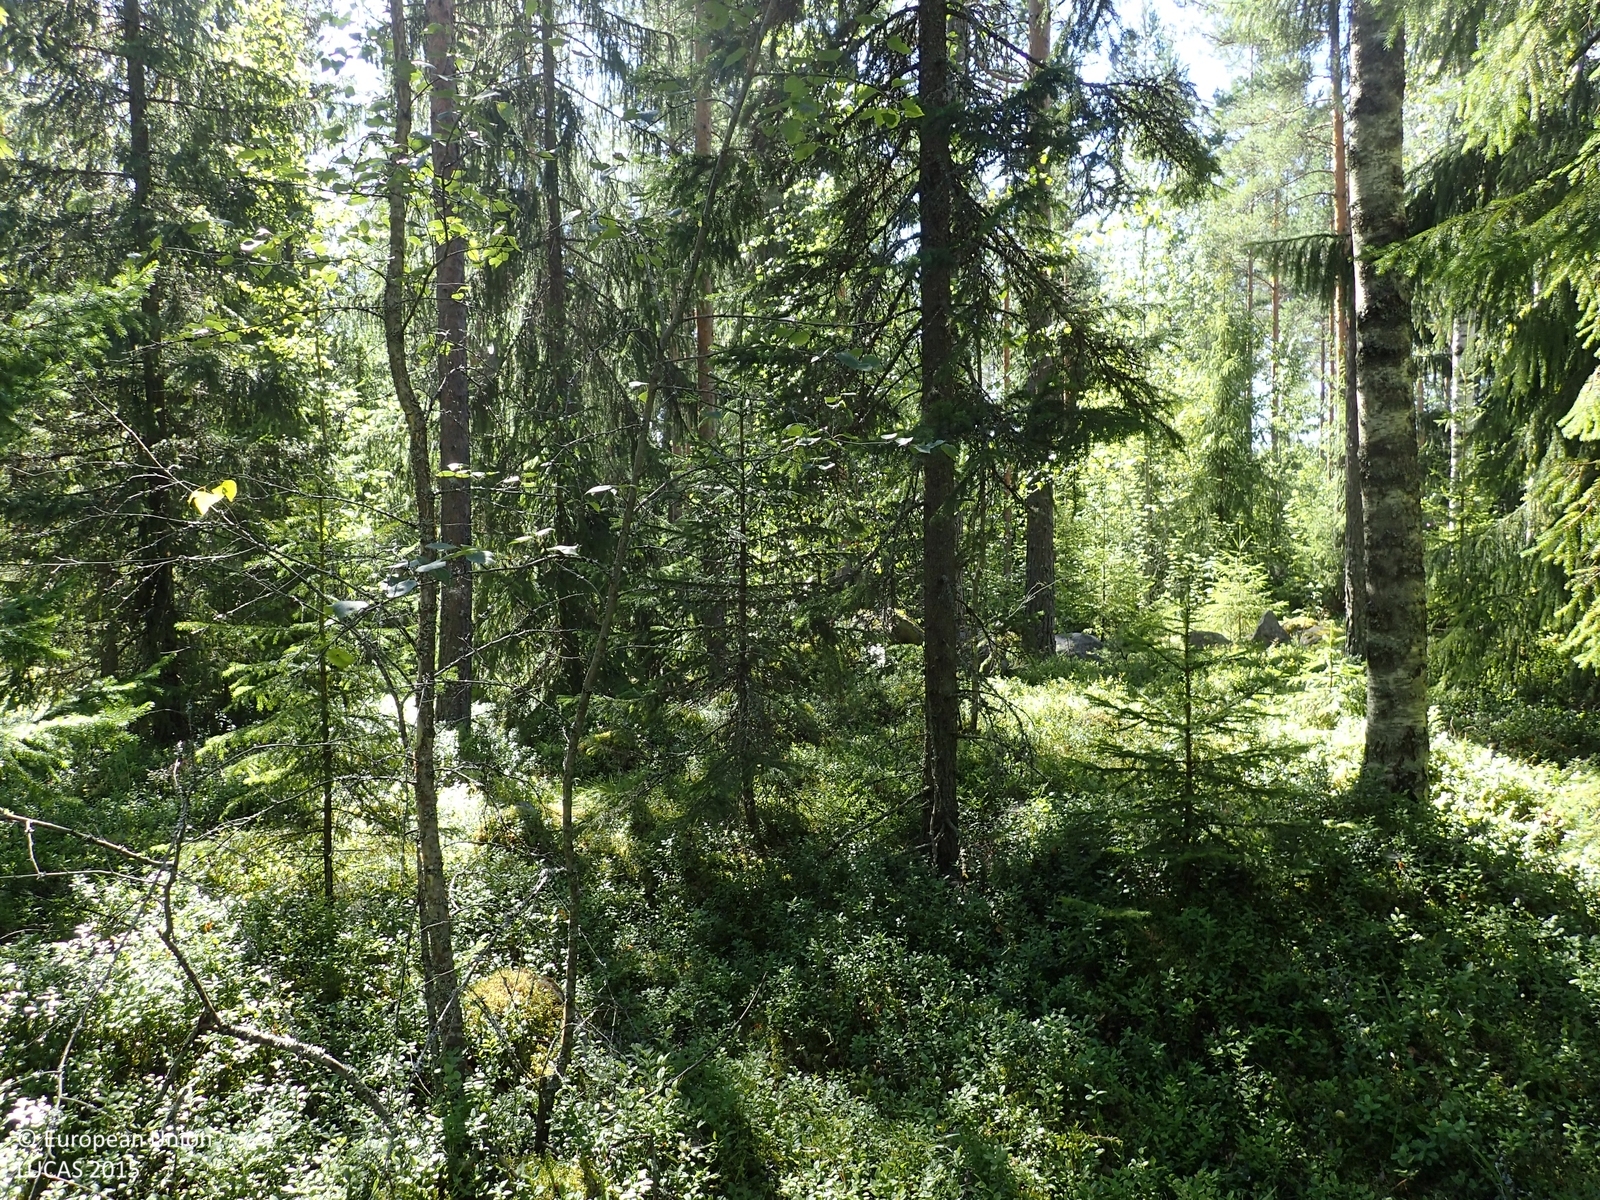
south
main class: Woodland
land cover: Other mixed woodland
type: boreal forest
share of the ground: > 75 %
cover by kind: coniferous forest trees 55 %, shrubs 25 %, broadleaved forest trees 20 %
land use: Forestry
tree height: > 5 m
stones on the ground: < 10 %
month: August
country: FI
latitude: 62.5001
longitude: 22.6173
